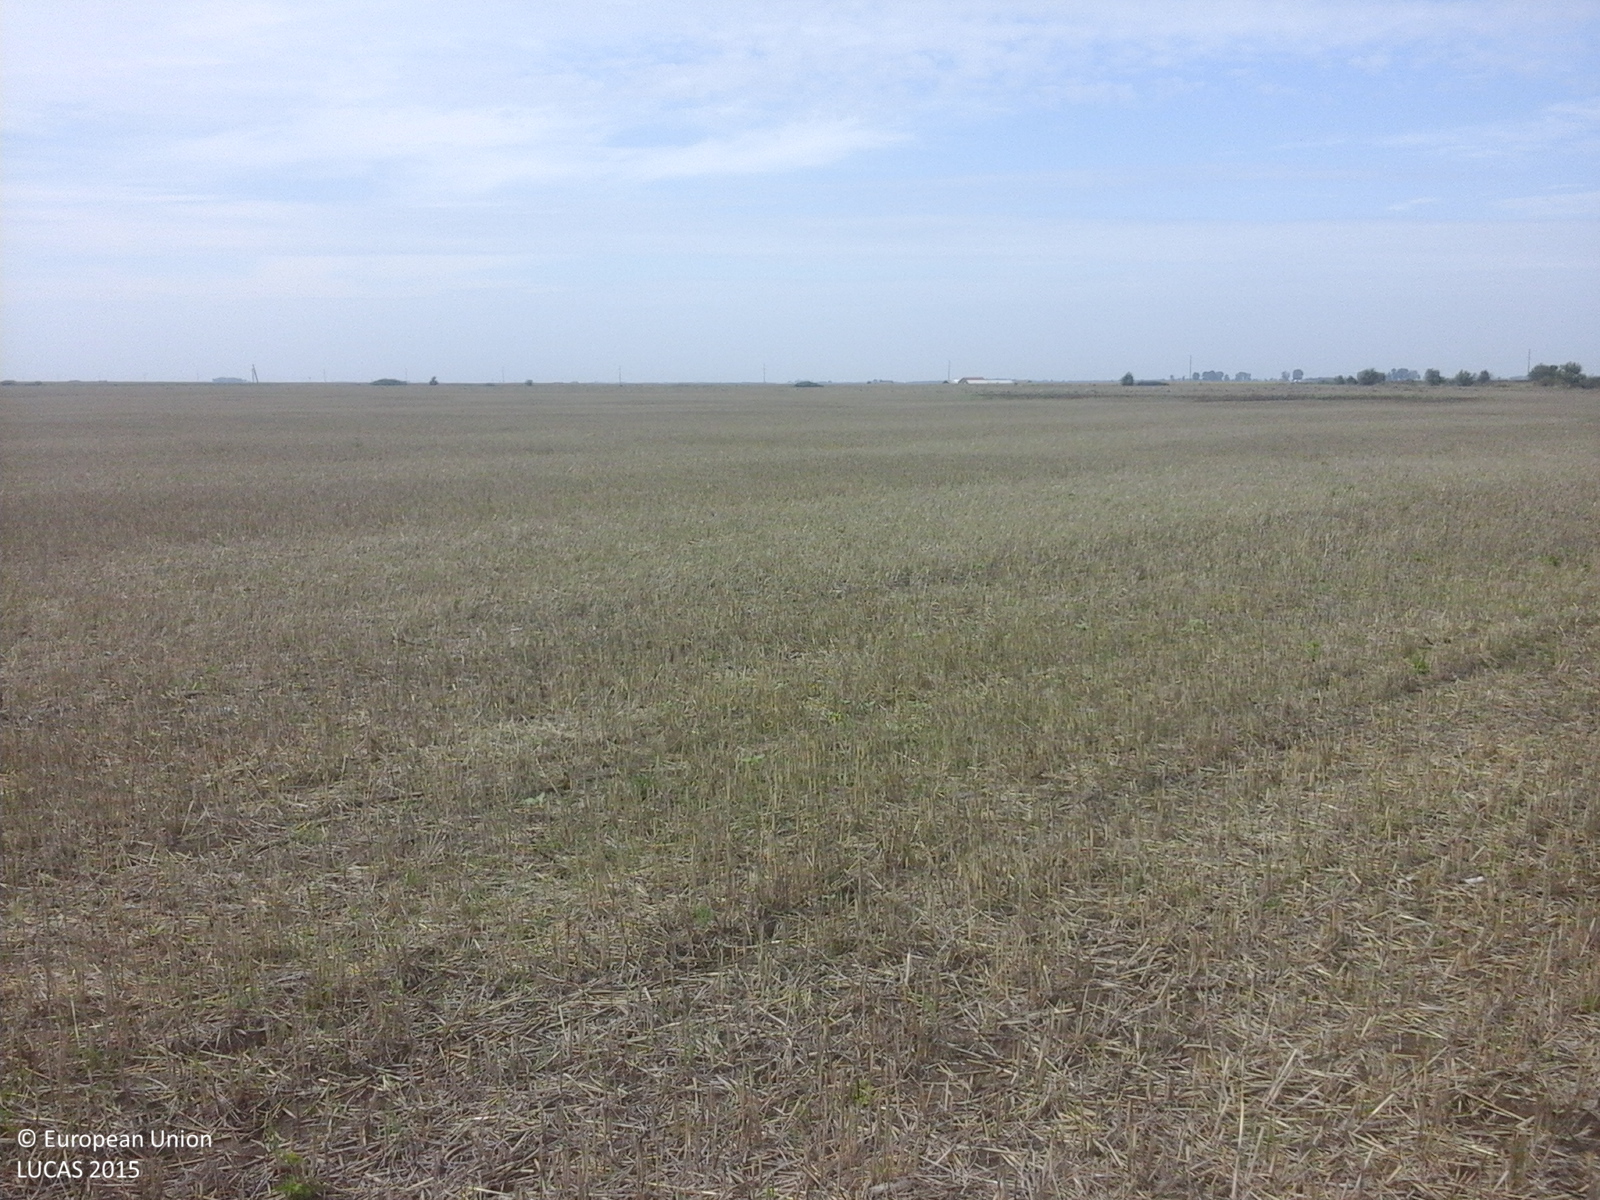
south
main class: Cropland
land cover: Common wheat
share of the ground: 50 - 75 %
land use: Agriculture (excluding fallow land and kitchen gardens)
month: August
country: RO
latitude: 46.4102
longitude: 21.4191
